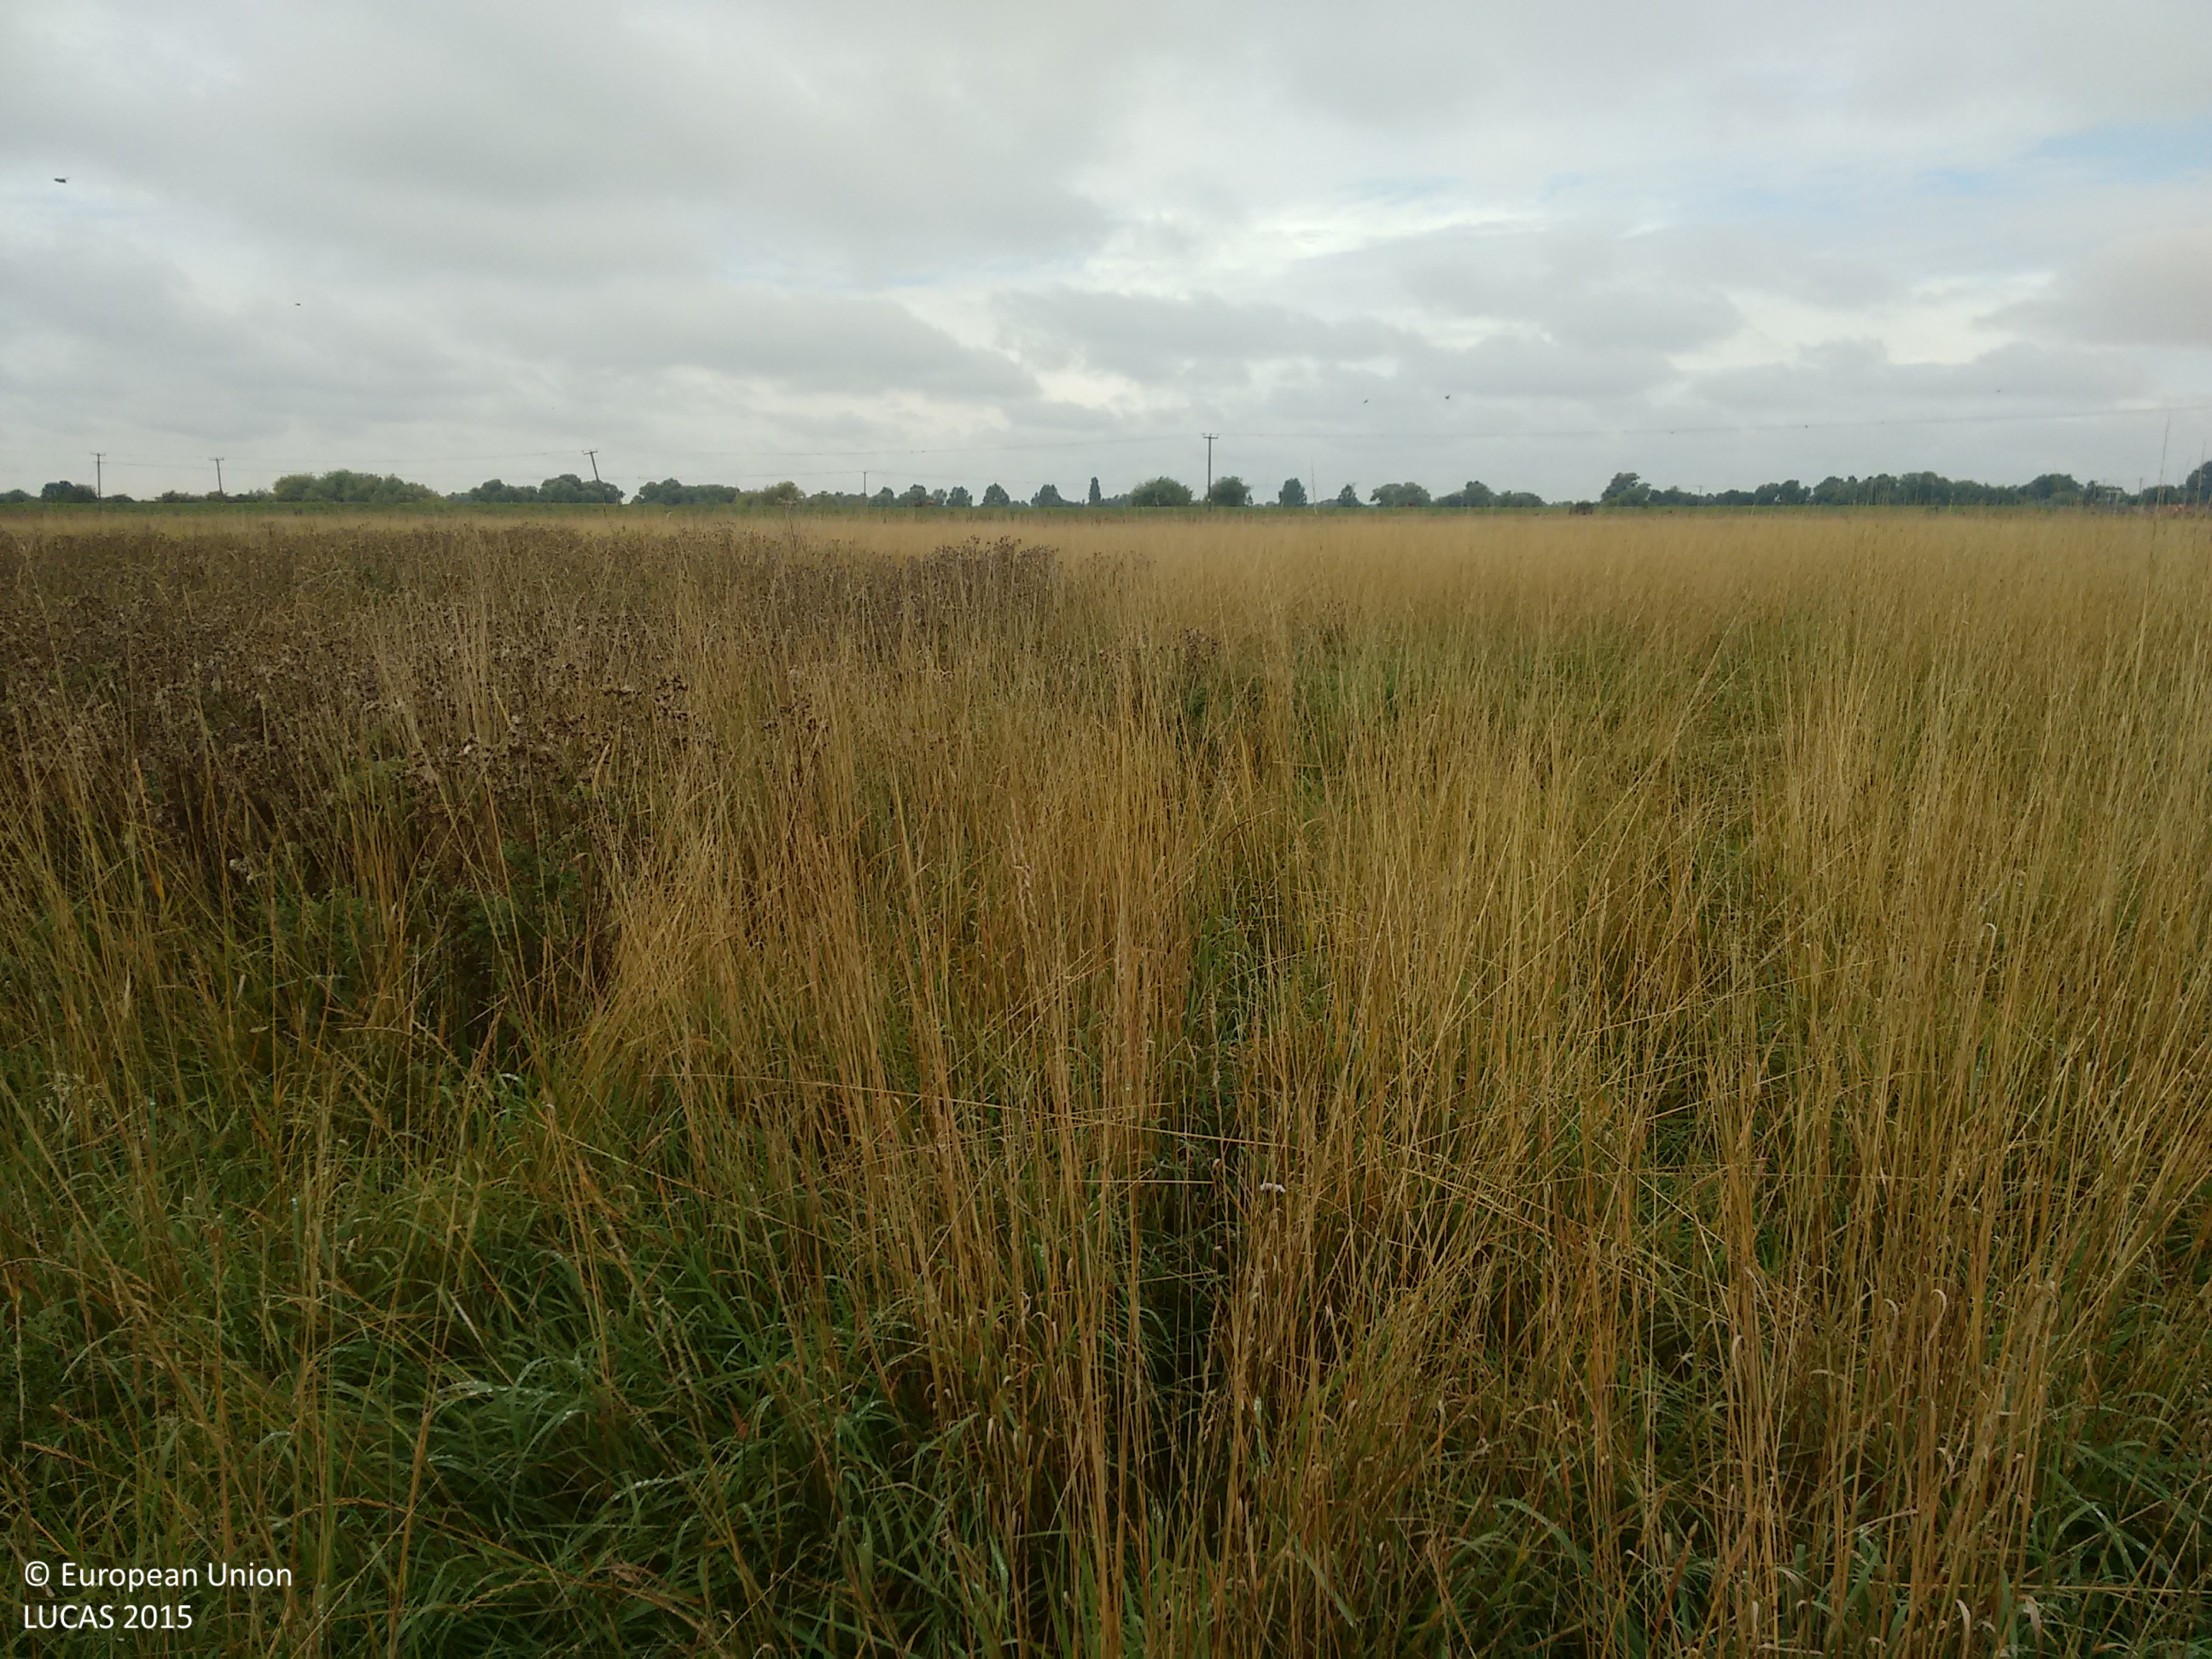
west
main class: Grassland
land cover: Grassland without tree/shrub cover
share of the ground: > 75 %
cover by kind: herbaceous plants 100 %
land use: Agriculture (excluding fallow land and kitchen gardens)
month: September
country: GB
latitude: 52.3171
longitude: 0.0066
